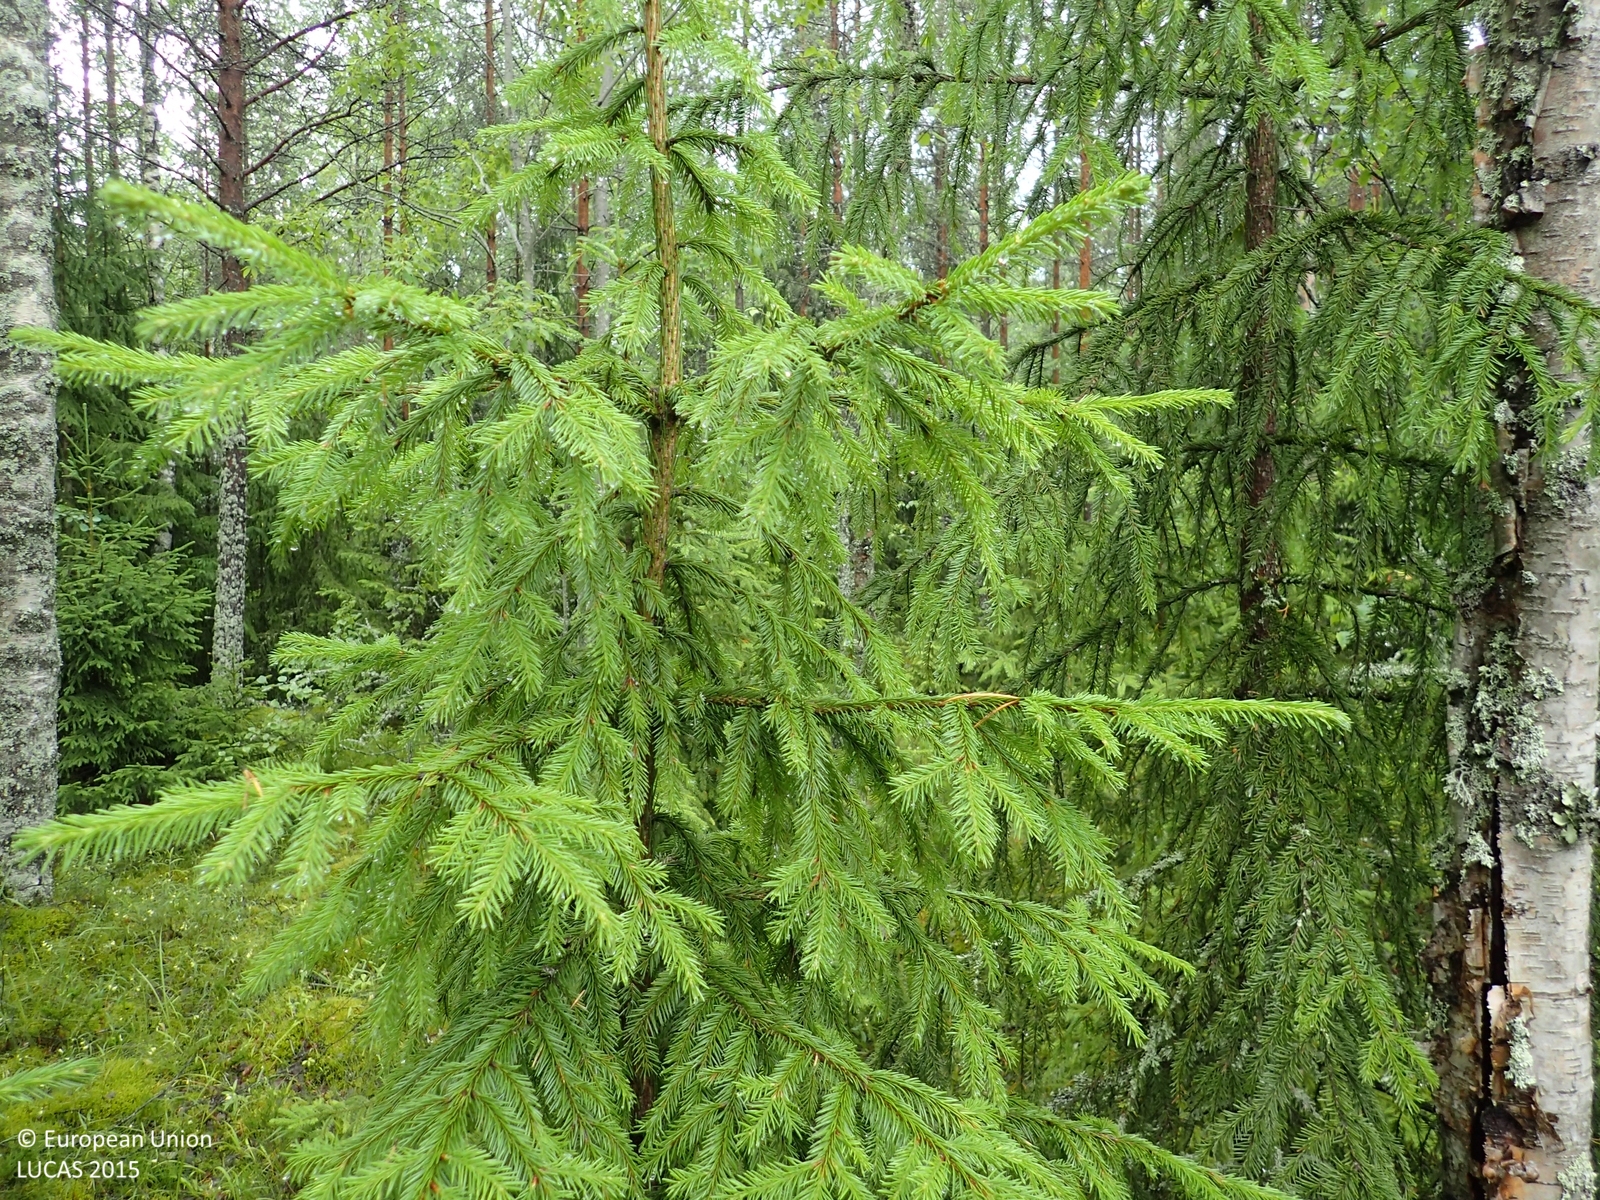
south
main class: Woodland
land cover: Pine dominated mixed woodland
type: boreal forest
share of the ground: 50 - 75 %
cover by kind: broadleaved forest trees 40 %, coniferous forest trees 20 %, shrubs 20 %, herbaceous plants 10 %, lichens and mosses 10 %
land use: Forestry
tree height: > 5 m
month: July
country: FI
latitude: 62.9826
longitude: 21.6236
